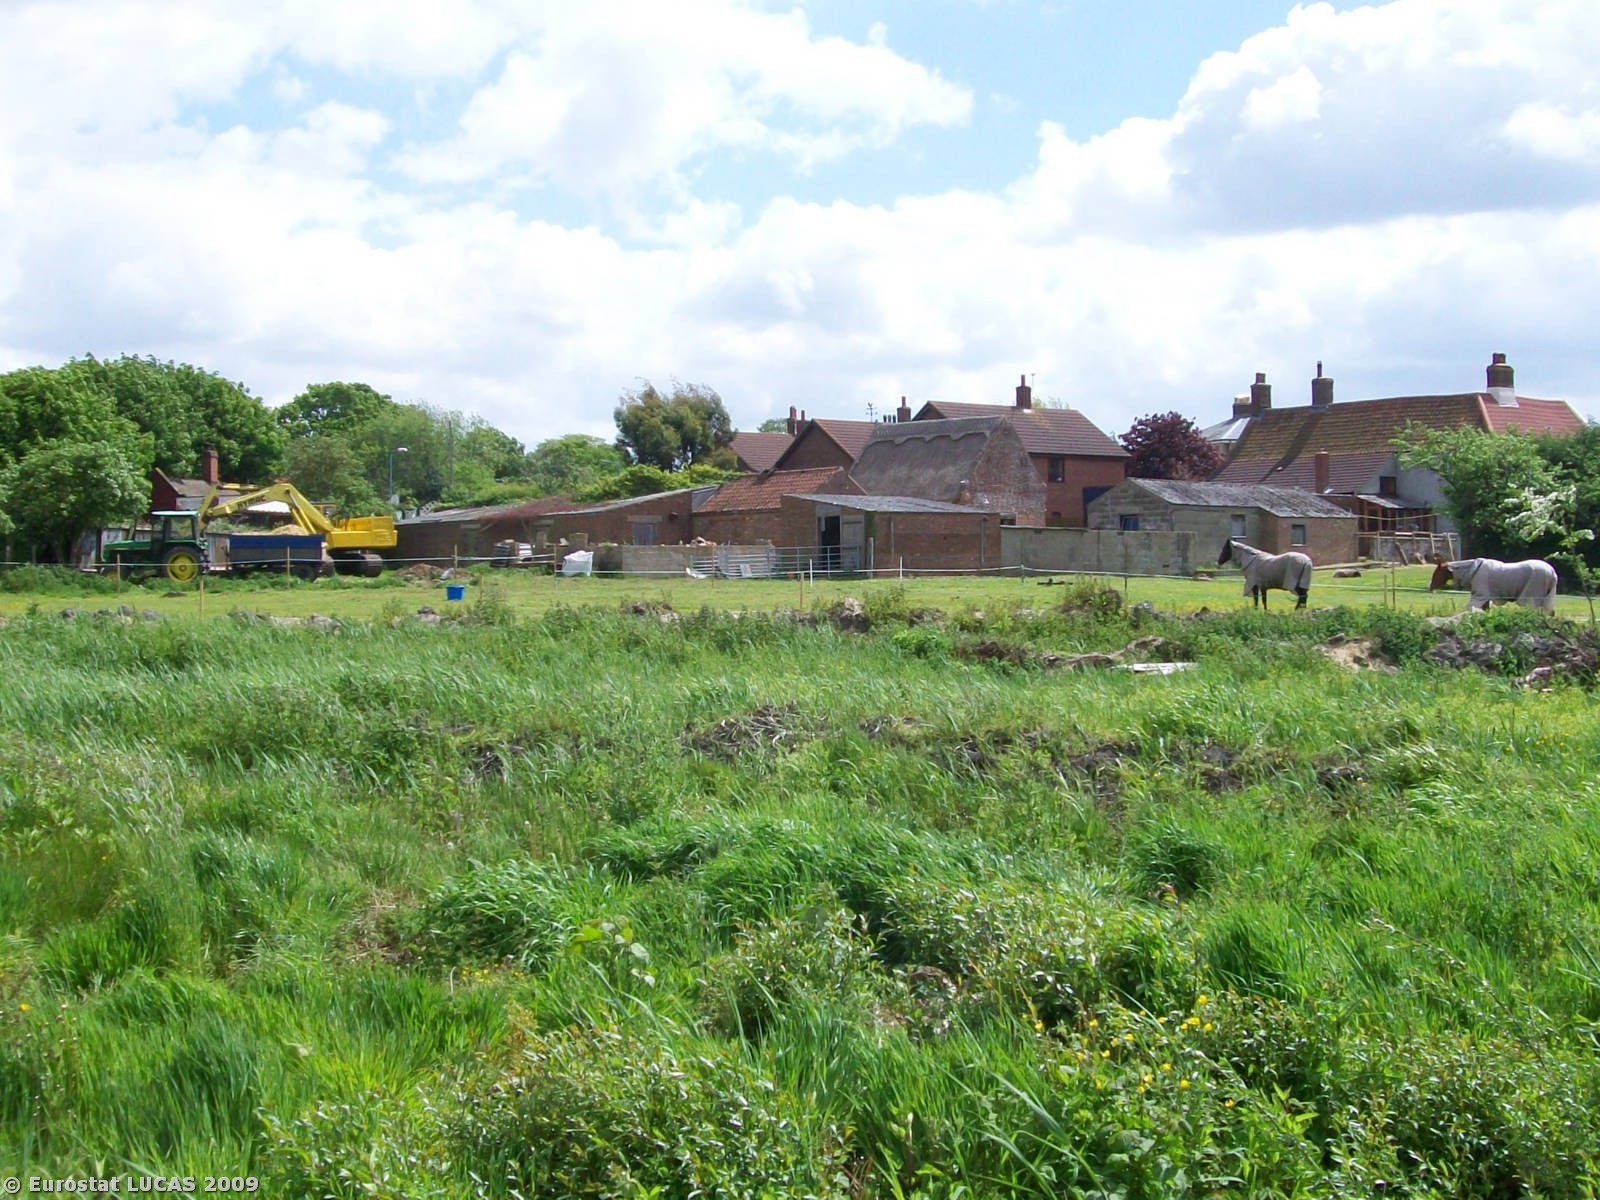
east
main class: Grassland
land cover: Grassland without tree/shrub cover
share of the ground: > 75 %
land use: Unused
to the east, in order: Grassland without tree/shrub cover; Fences; Grassland without tree/shrub cover; Fences; Railways; Fences; Artificial constructions in urban areas; Fences; Paved roads, cycling and walking lanes; Fences; Mixed woodland
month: May
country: GB
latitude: 52.5645
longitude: 1.5578
